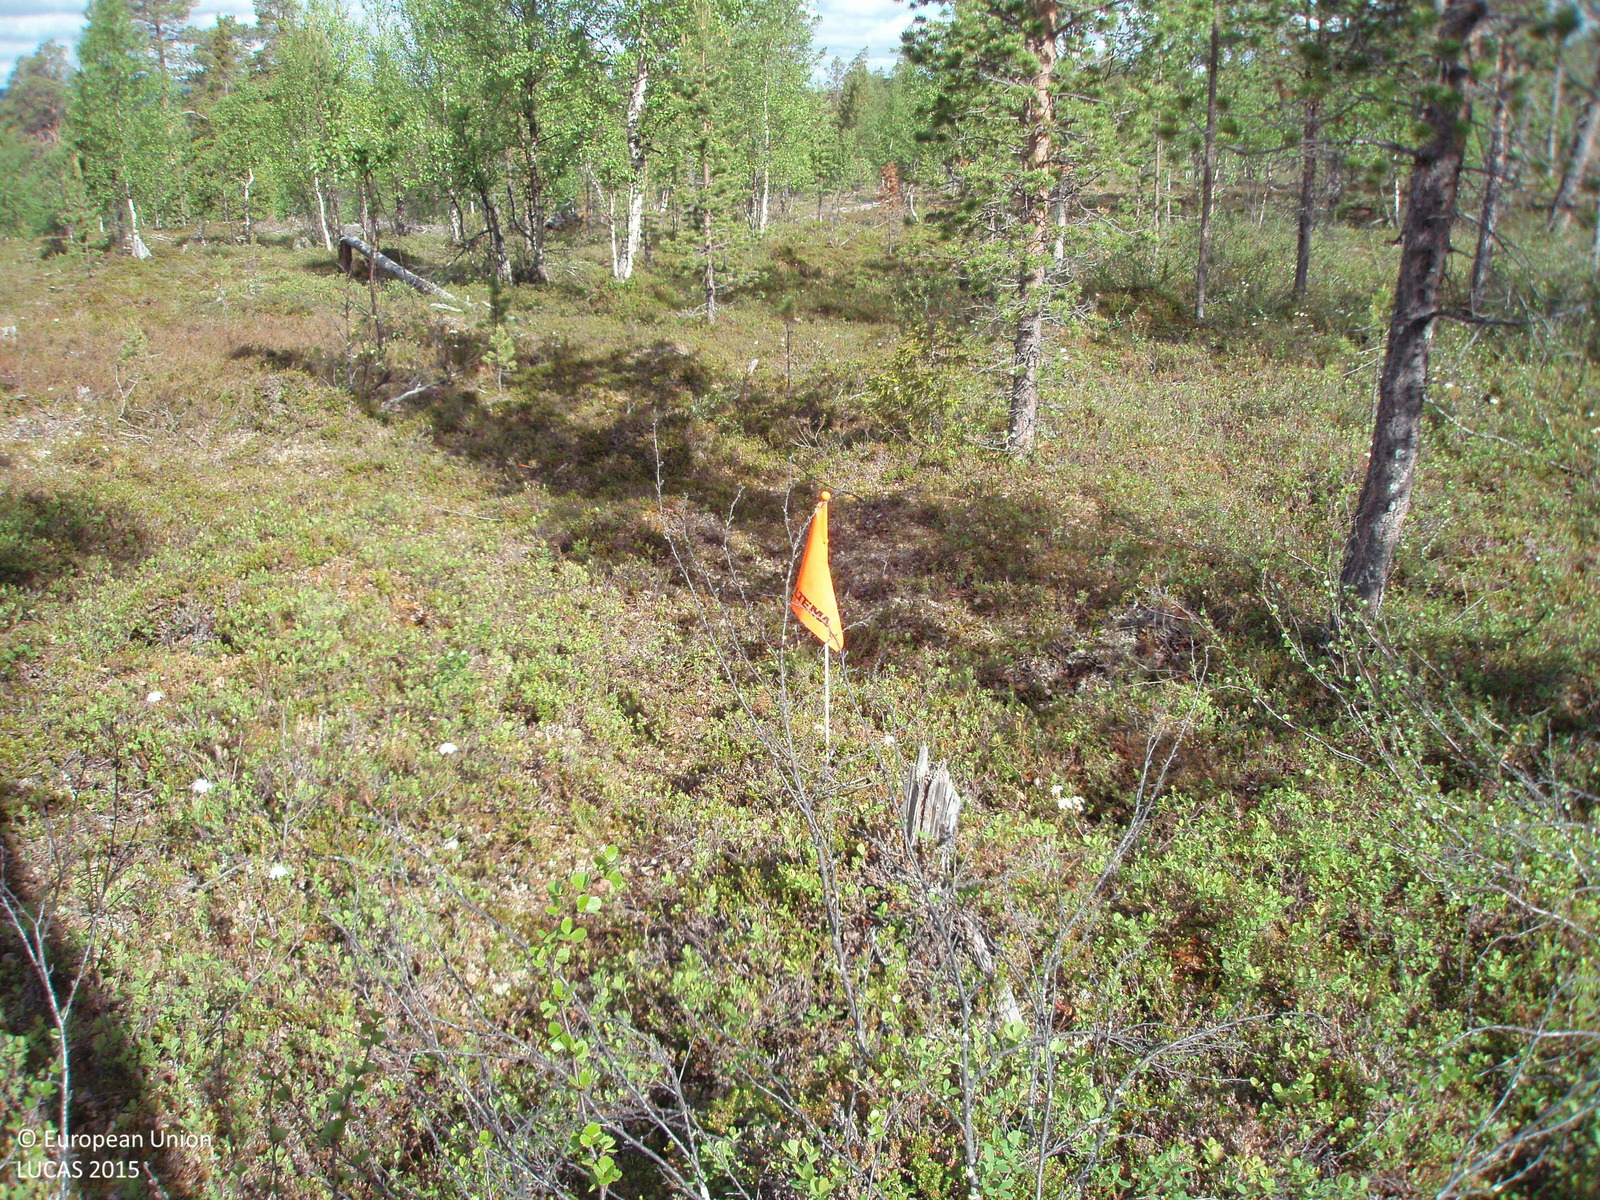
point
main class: Woodland
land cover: Pine dominated mixed woodland
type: boreal forest
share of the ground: 25 - 50 %
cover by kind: shrubs 50 %, broadleaved forest trees 25 %, coniferous forest trees 20 %, lichens and mosses 5 %
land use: Forestry
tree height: > 5 m
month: June
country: FI
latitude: 68.6567
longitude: 26.3216
